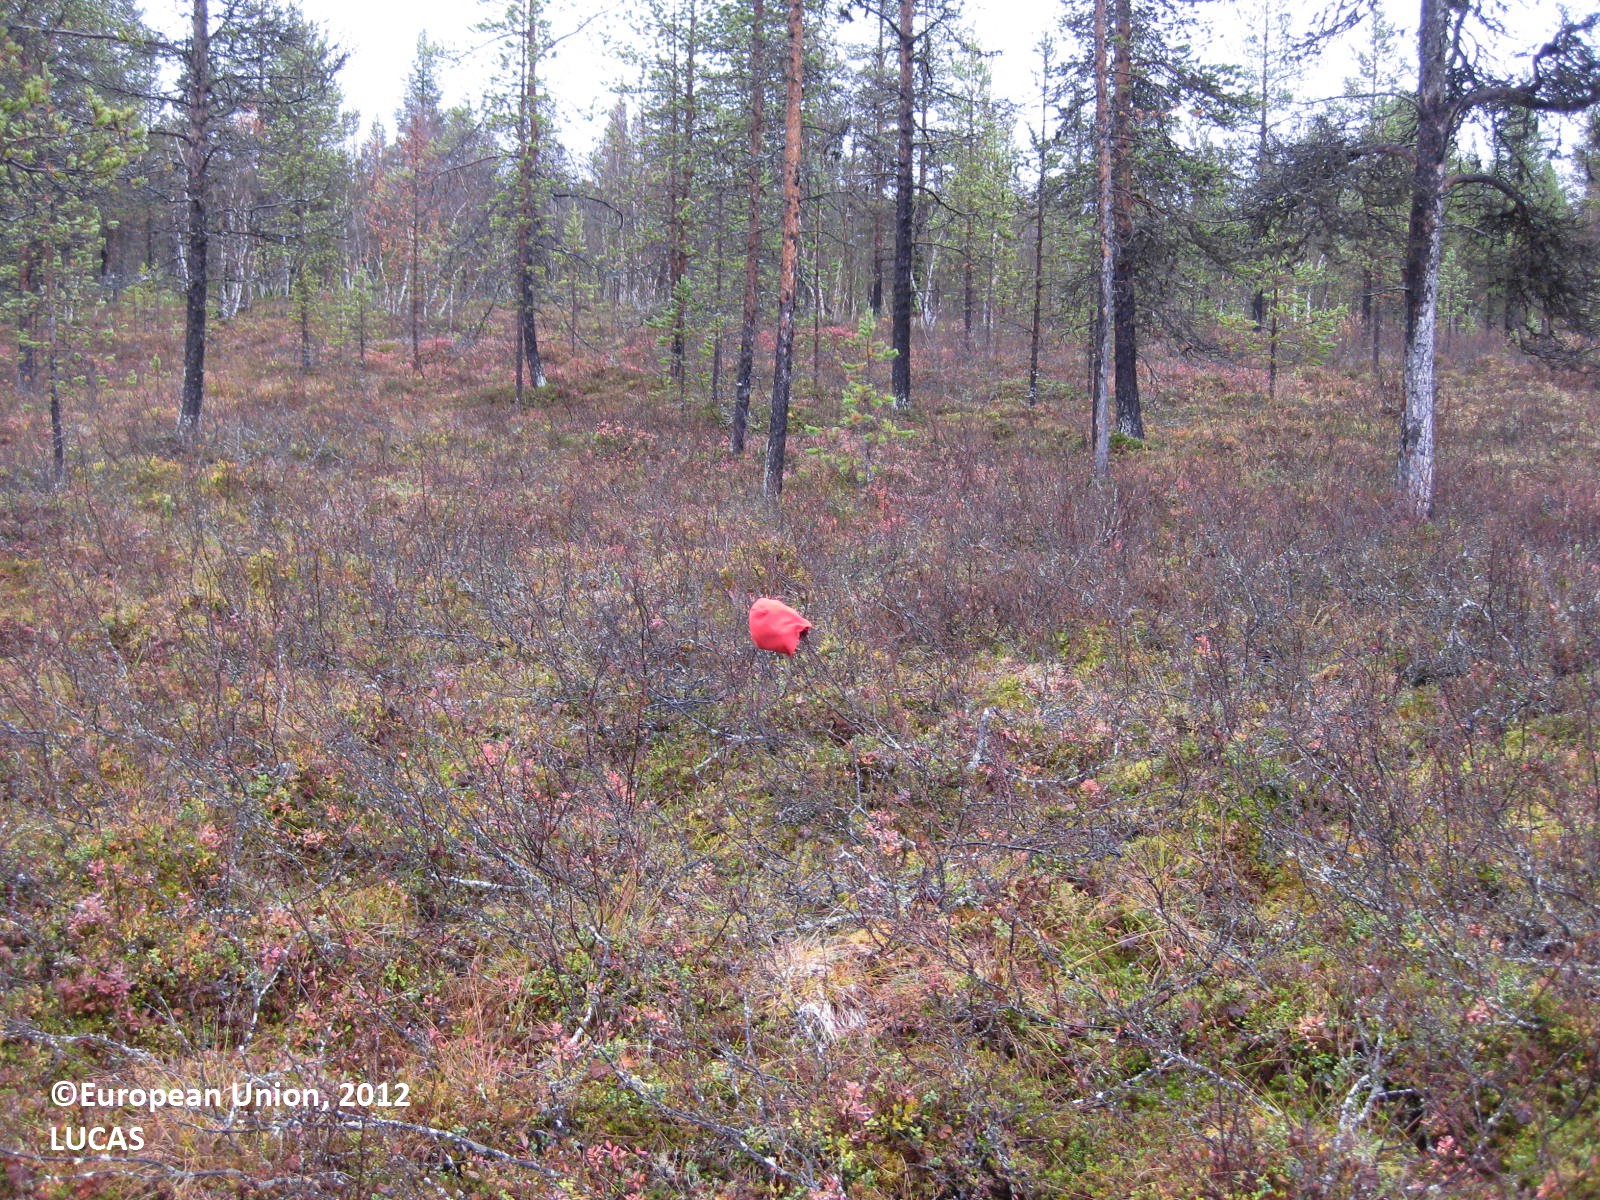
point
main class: Woodland
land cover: Pine dominated coniferous woodland
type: boreal forest
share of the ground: 25 - 50 %
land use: Forestry
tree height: > 5 m
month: September
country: FI
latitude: 68.2171
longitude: 23.3089
